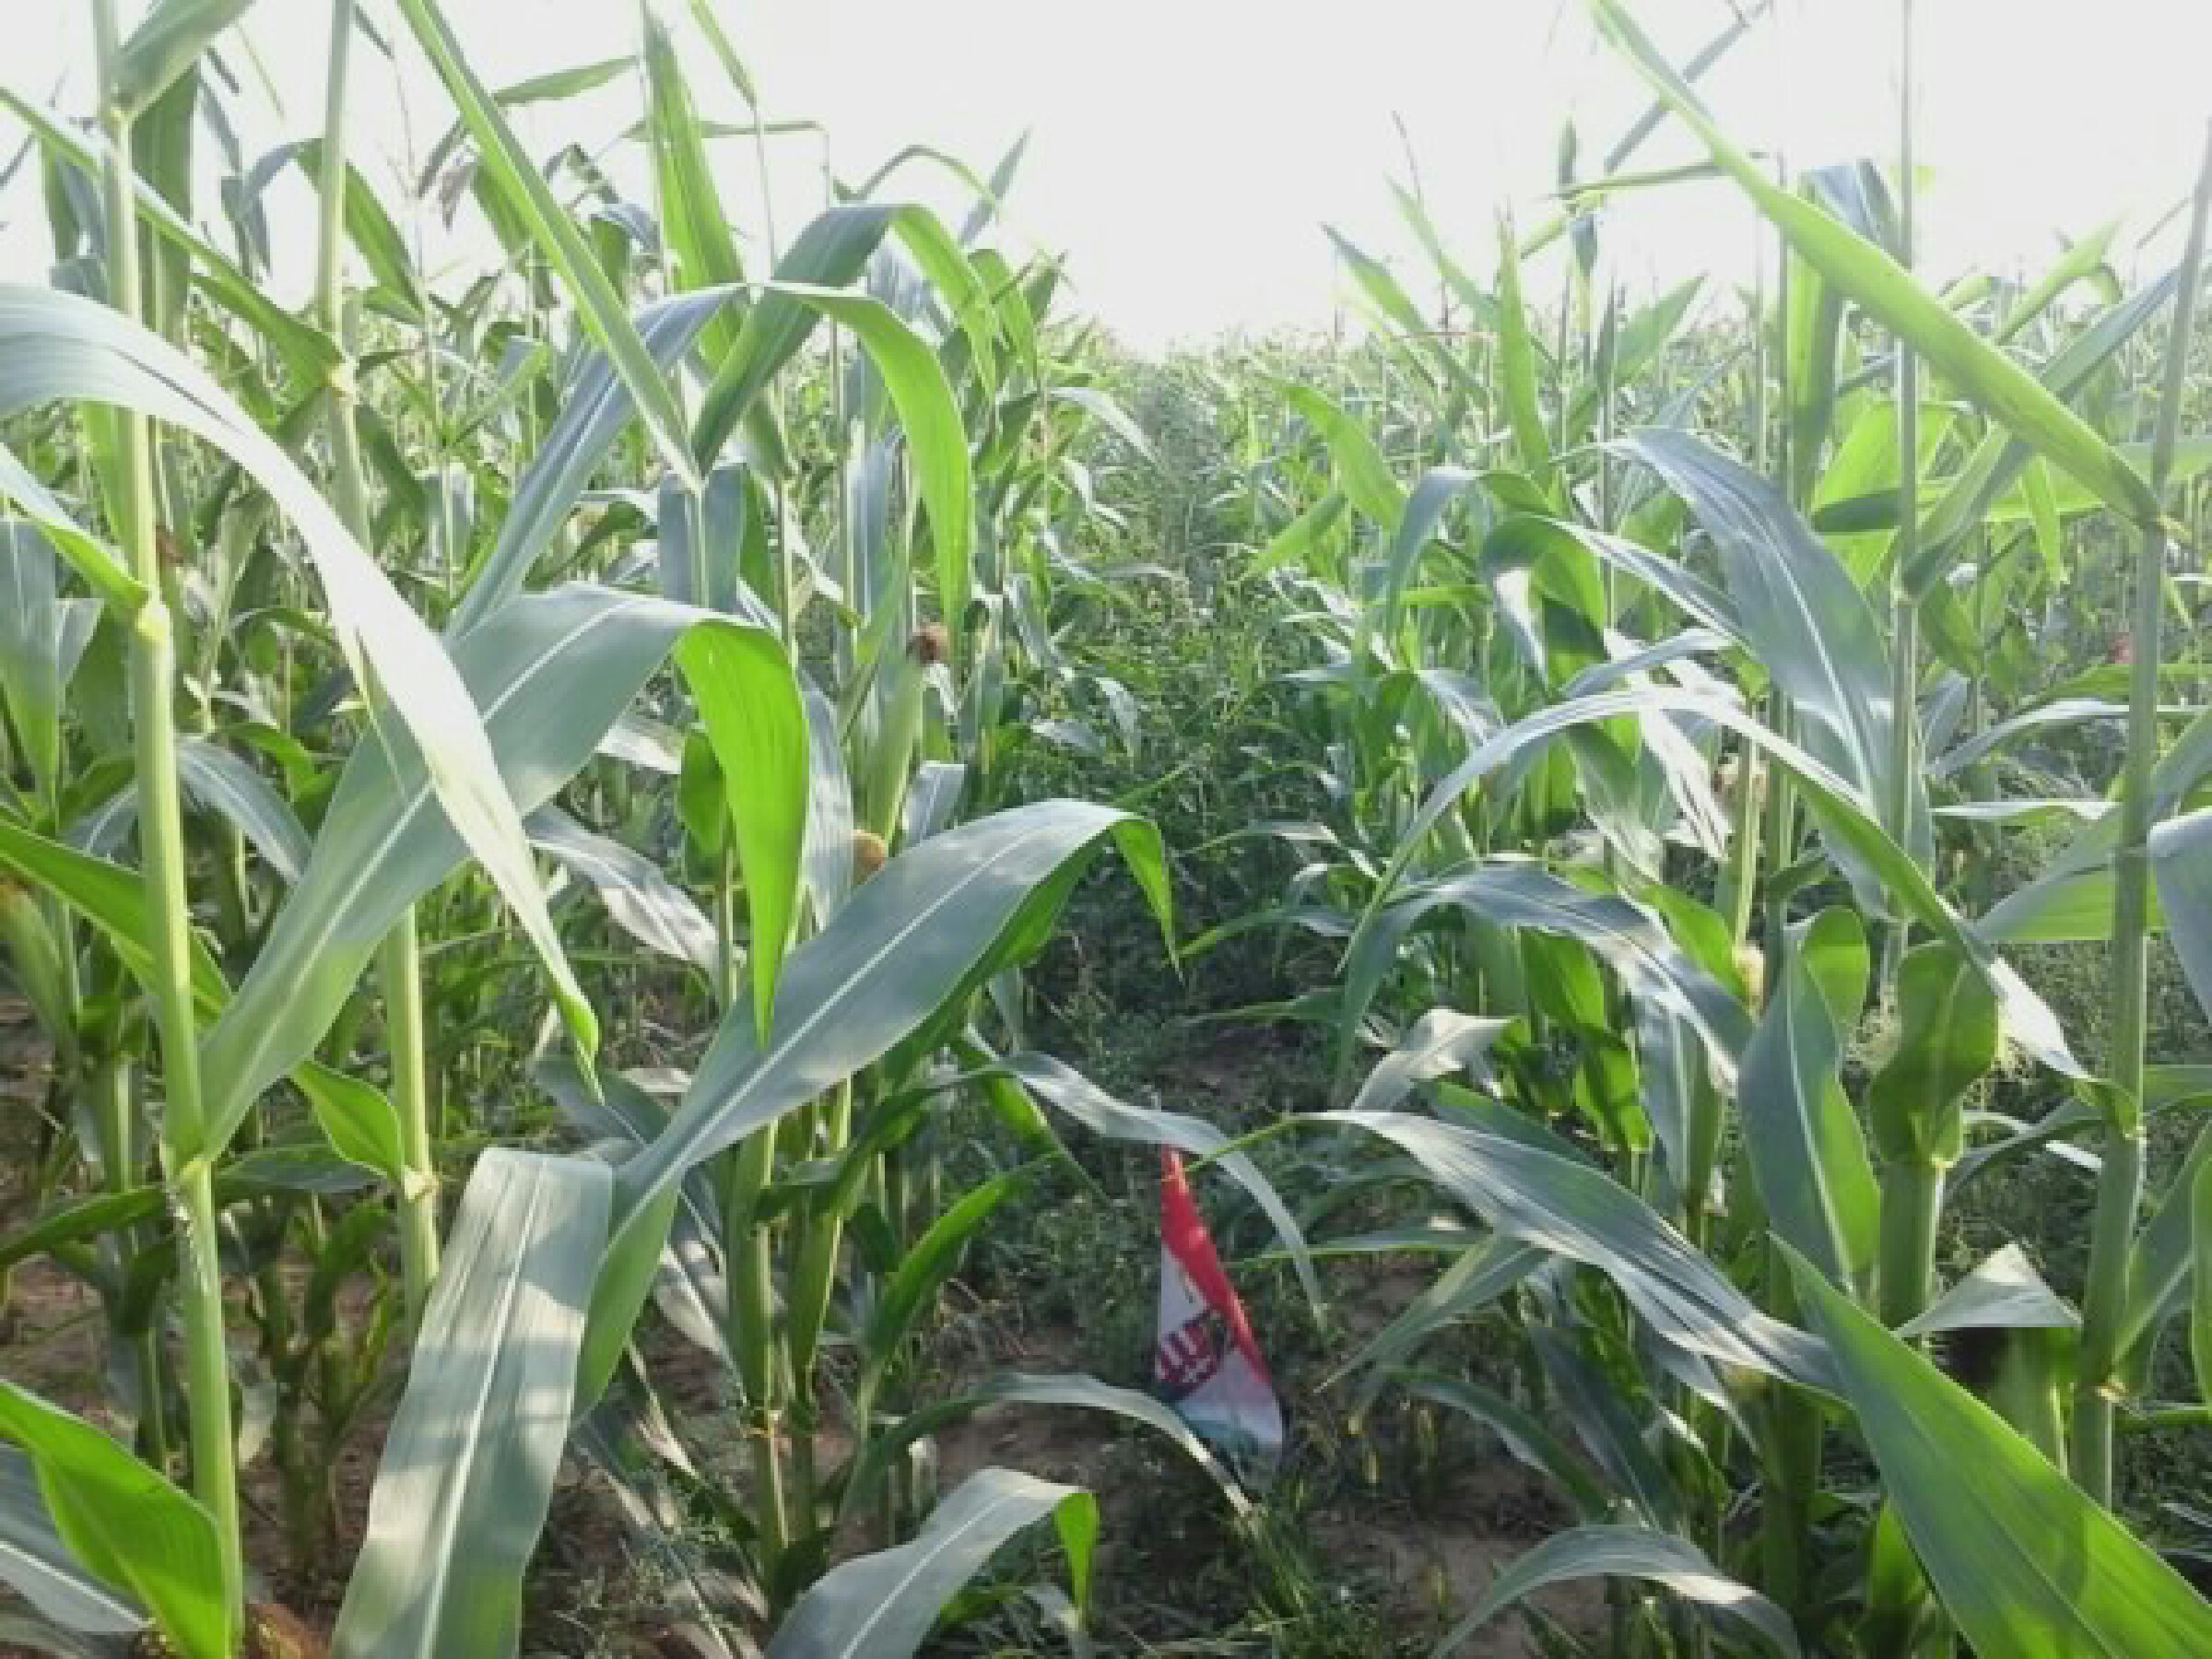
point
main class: Cropland
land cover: Maize
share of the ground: > 75 %
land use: Agriculture (excluding fallow land and kitchen gardens)
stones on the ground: < 10 %
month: August
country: HU
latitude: 48.0565
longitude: 19.4013
